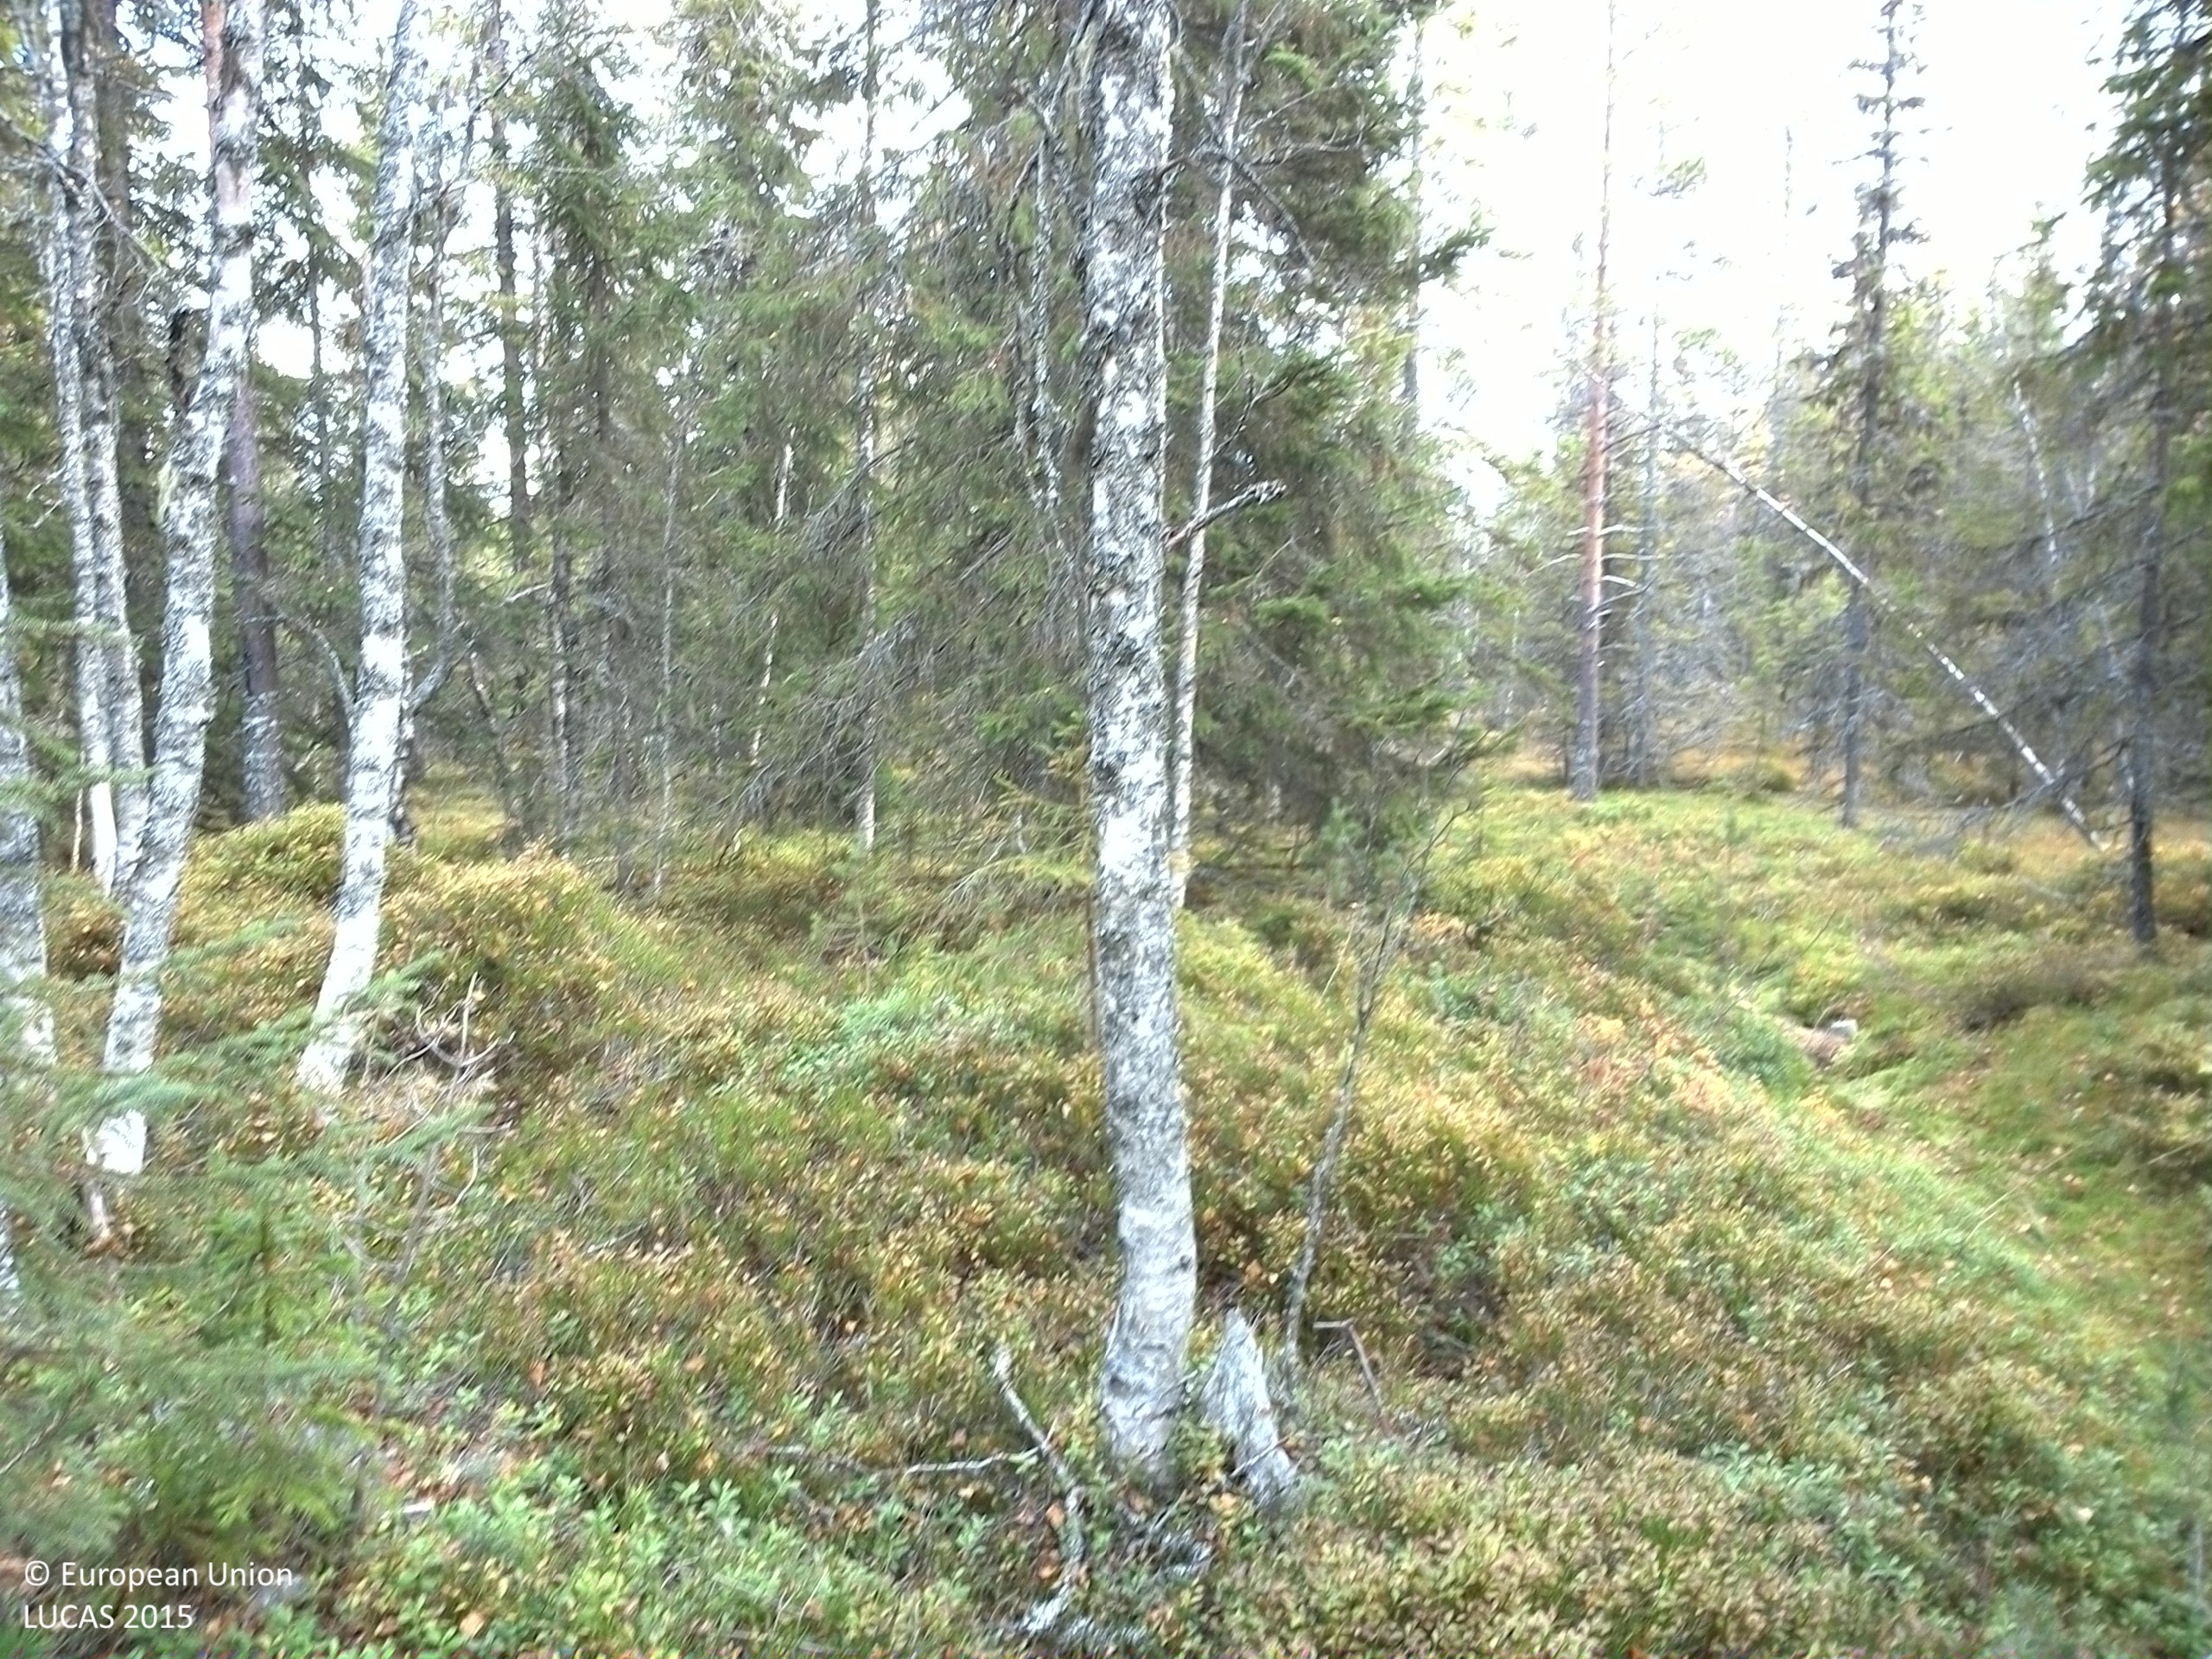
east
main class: Woodland
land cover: Spruce dominated mixed woodland
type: boreal forest
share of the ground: 50 - 75 %
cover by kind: coniferous forest trees 40 %, shrubs 30 %, broadleaved forest trees 20 %, lichens and mosses 10 %
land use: Forestry
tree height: > 5 m
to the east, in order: Spruce dominated mixed woodland; Spruce dominated coniferous woodland; Ditches and canals; Spruce dominated coniferous woodland; Spruce dominated mixed woodland; Ditches and canals; Shrubland without tree cover; Paved roads, cycling and walking lanes; Shrubland without tree cover; Spruce dominated mixed woodland; Ditches and canals; Spruce dominated mixed woodland; Other coniferous woodland; Peatbogs
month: October
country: SE
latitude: 61.4211
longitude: 14.6512
